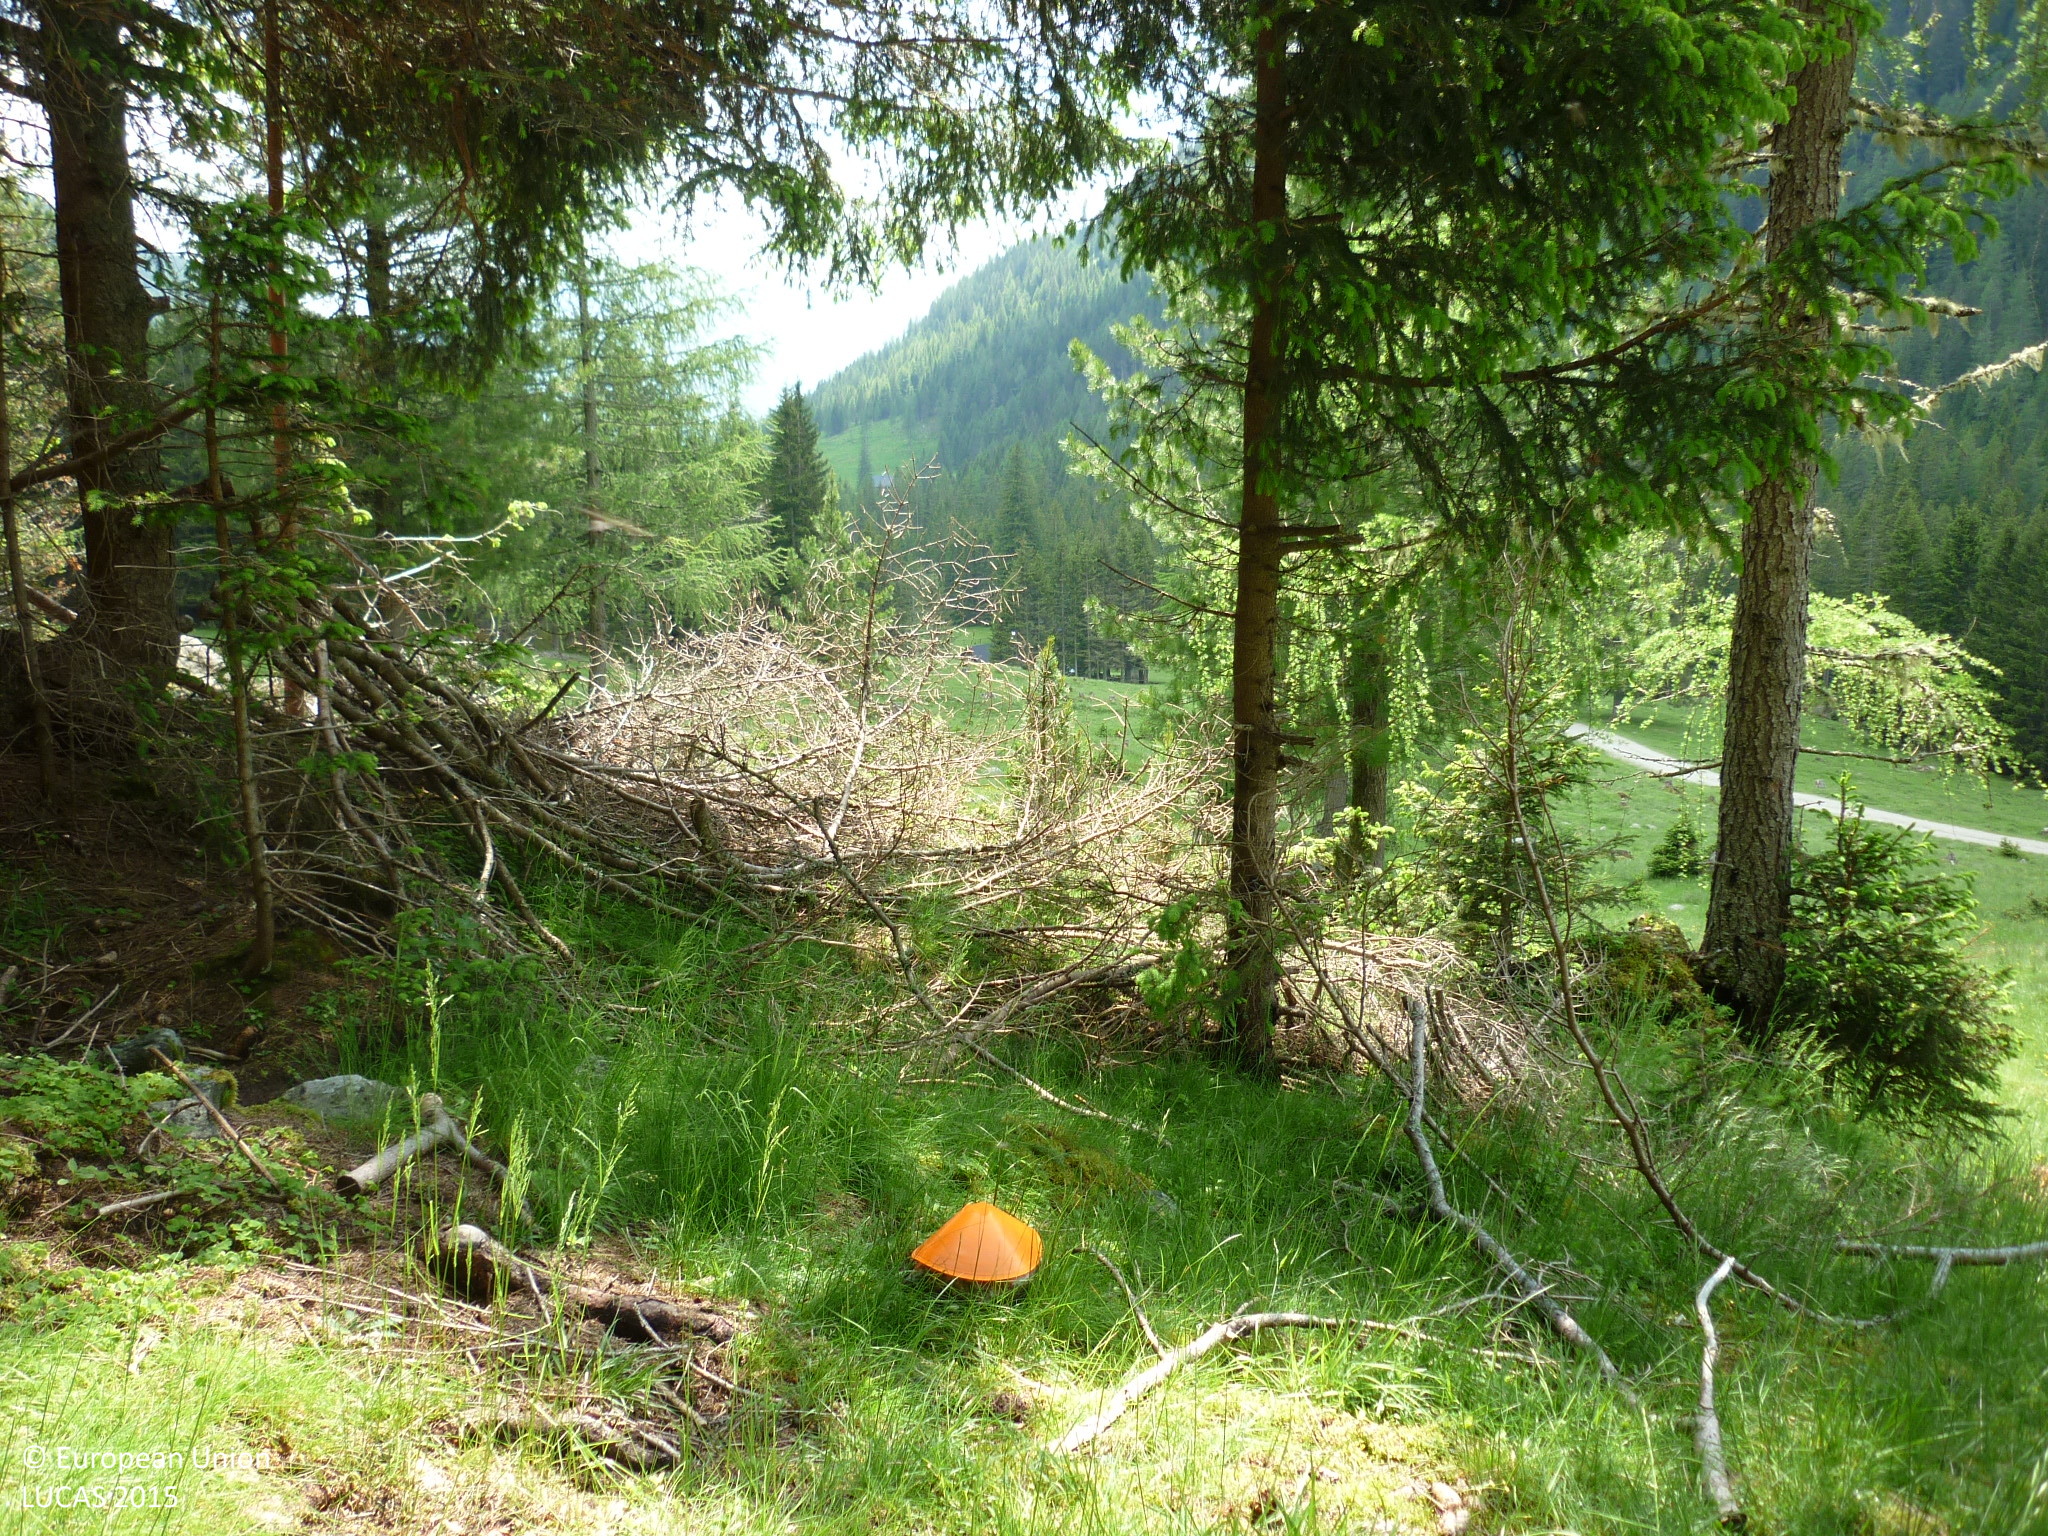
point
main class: Woodland
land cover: Spruce dominated coniferous woodland
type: alpine coniferous forest
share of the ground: > 75 %
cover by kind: coniferous forest trees 90 %, herbaceous plants 5 %, lichens and mosses 5 %
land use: Forestry
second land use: Amenities, museums, leisure
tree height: > 5 m
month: June
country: AT
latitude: 47.2329
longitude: 13.9740
